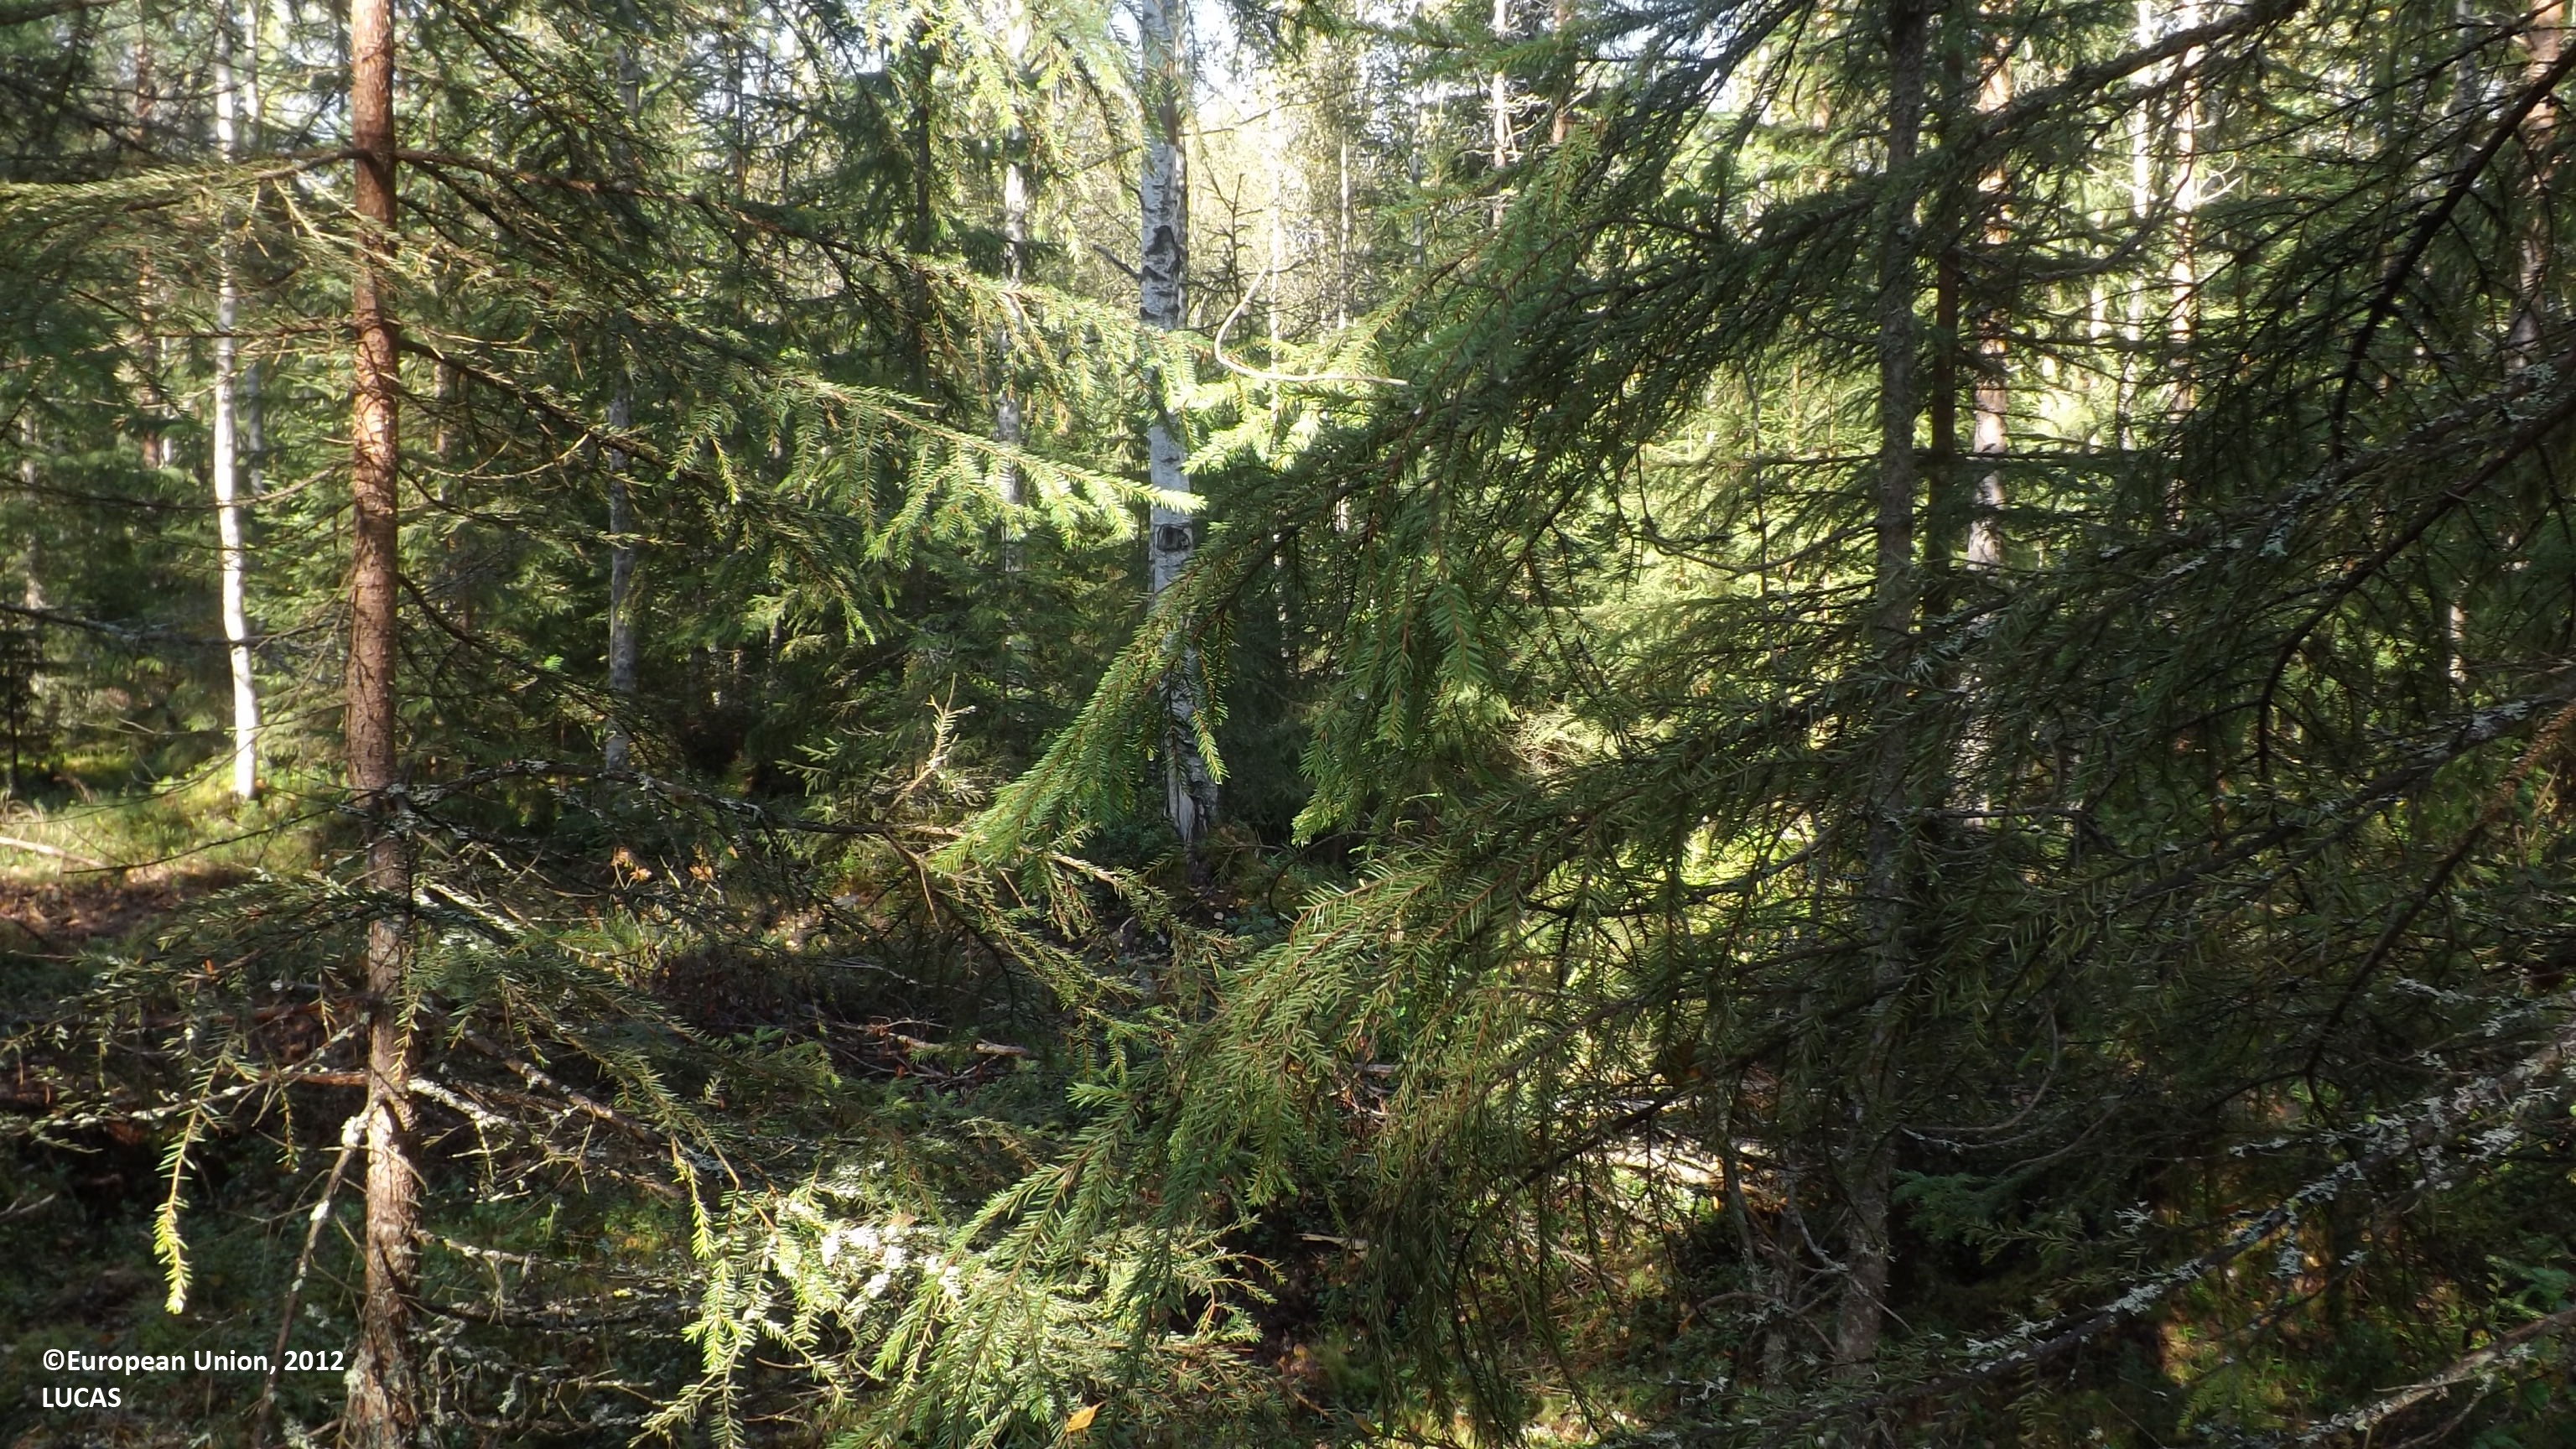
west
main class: Woodland
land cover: Spruce dominated mixed woodland
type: boreal forest
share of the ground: 50 - 75 %
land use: Forestry
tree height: > 5 m
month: August
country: FI
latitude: 63.6467
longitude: 23.7751
